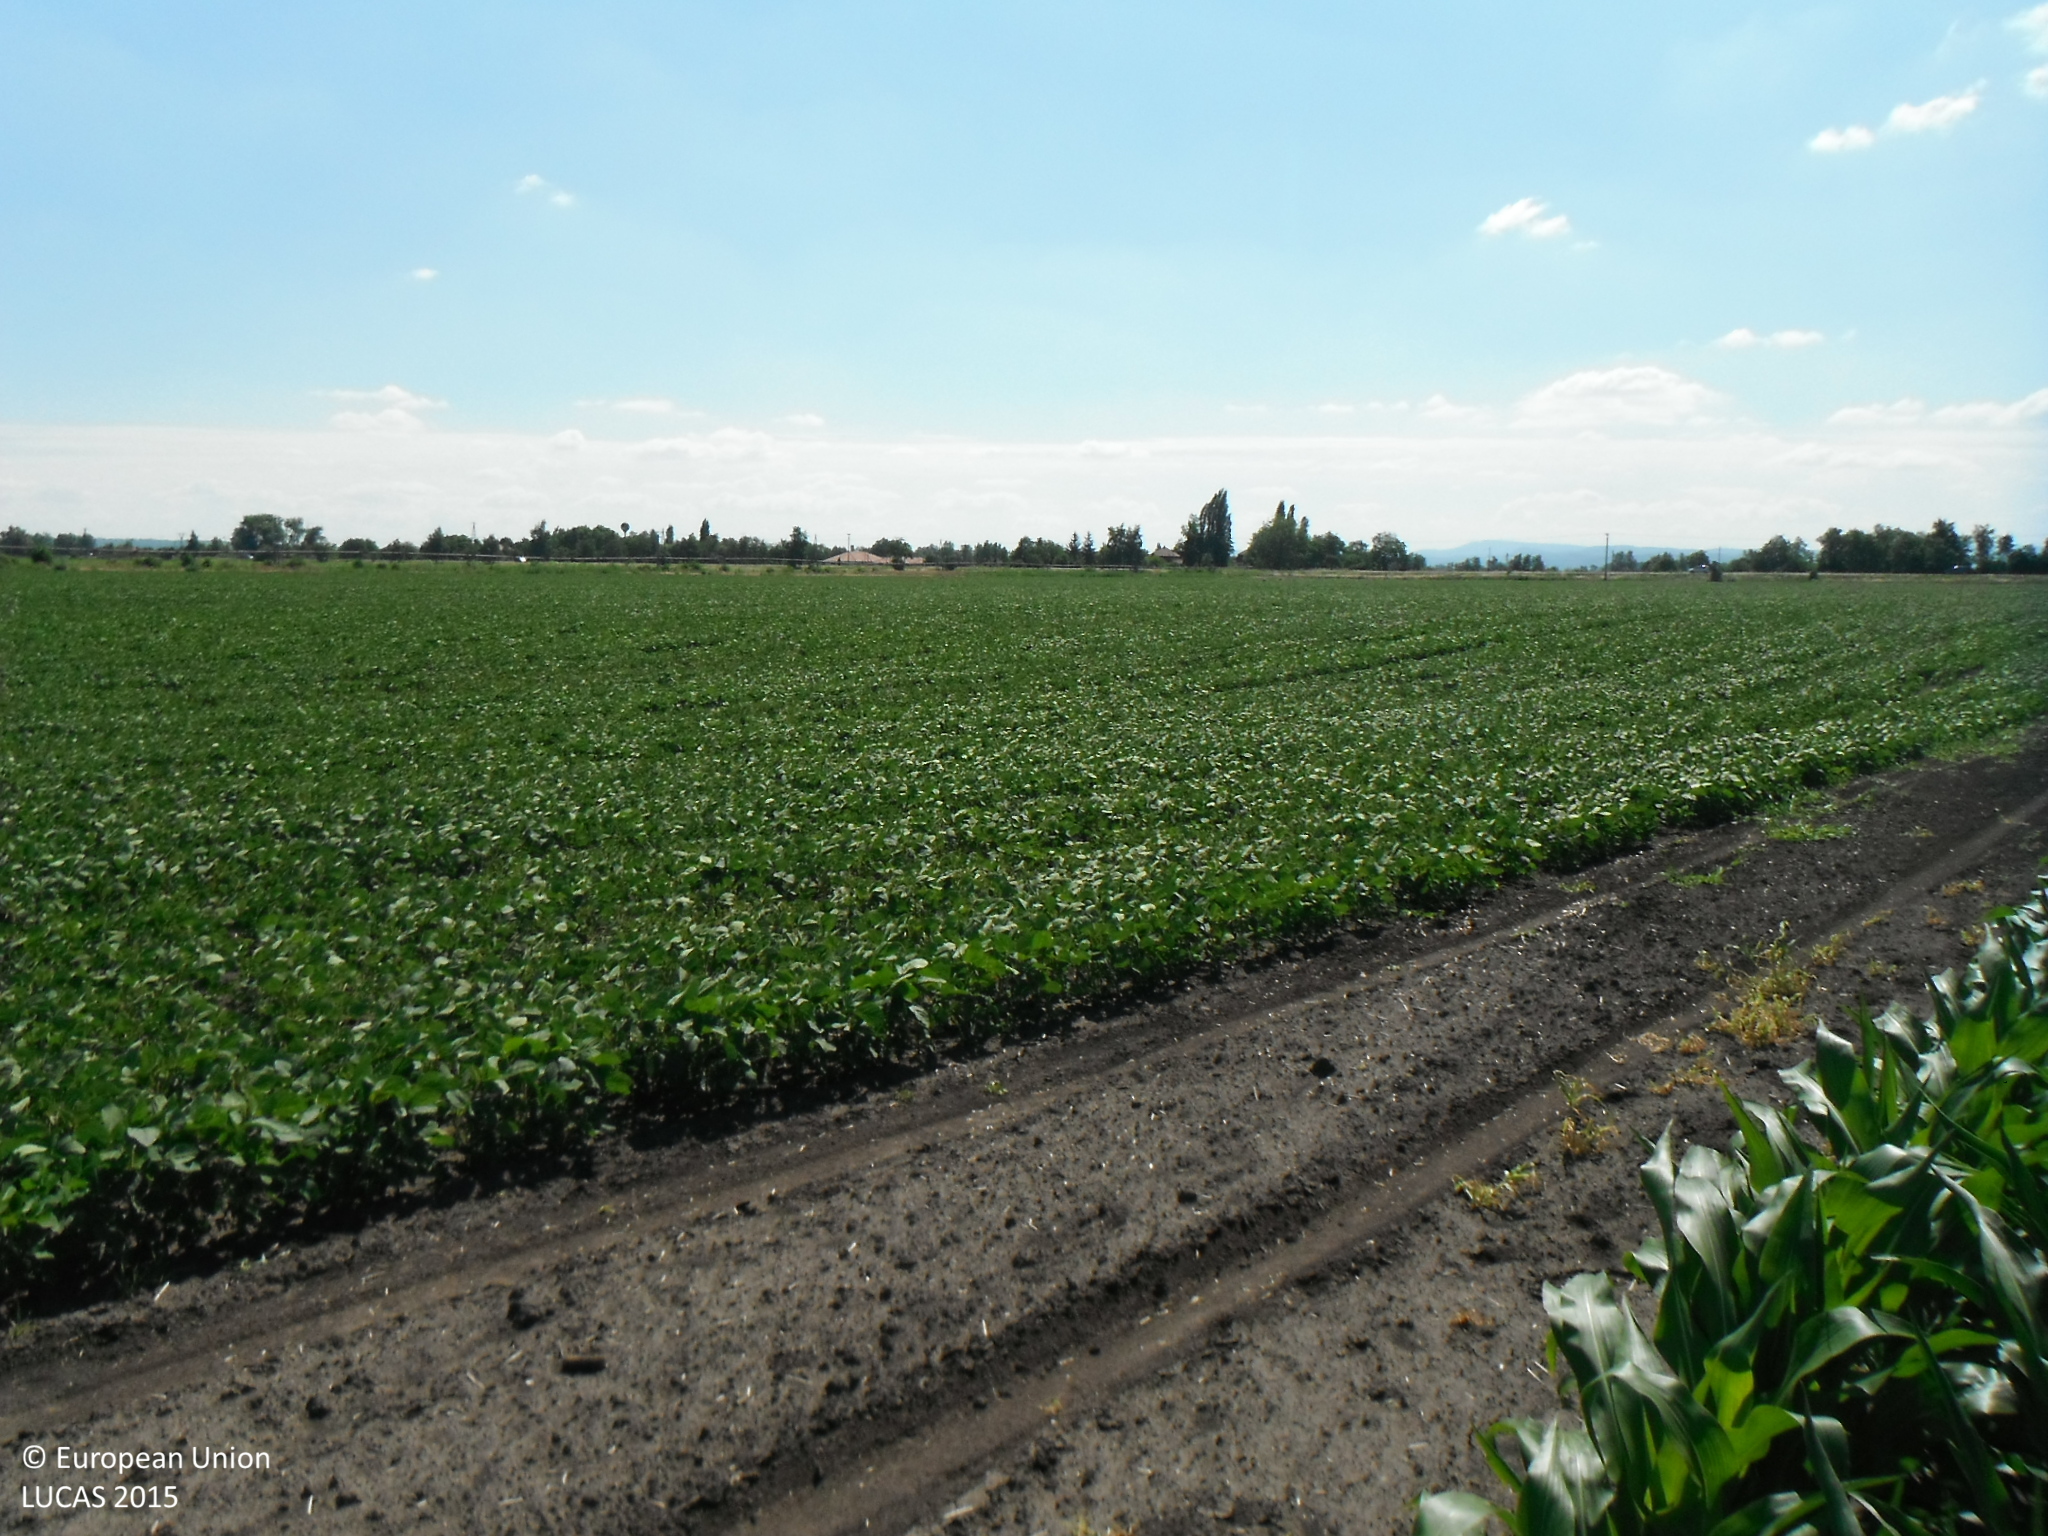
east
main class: Cropland
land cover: Maize
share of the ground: 50 - 75 %
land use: Agriculture (excluding fallow land and kitchen gardens)
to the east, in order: Maize; Other bare soil; Soya; Shrubland without tree cover; Soya
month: June
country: SK
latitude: 47.7934
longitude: 18.1693
